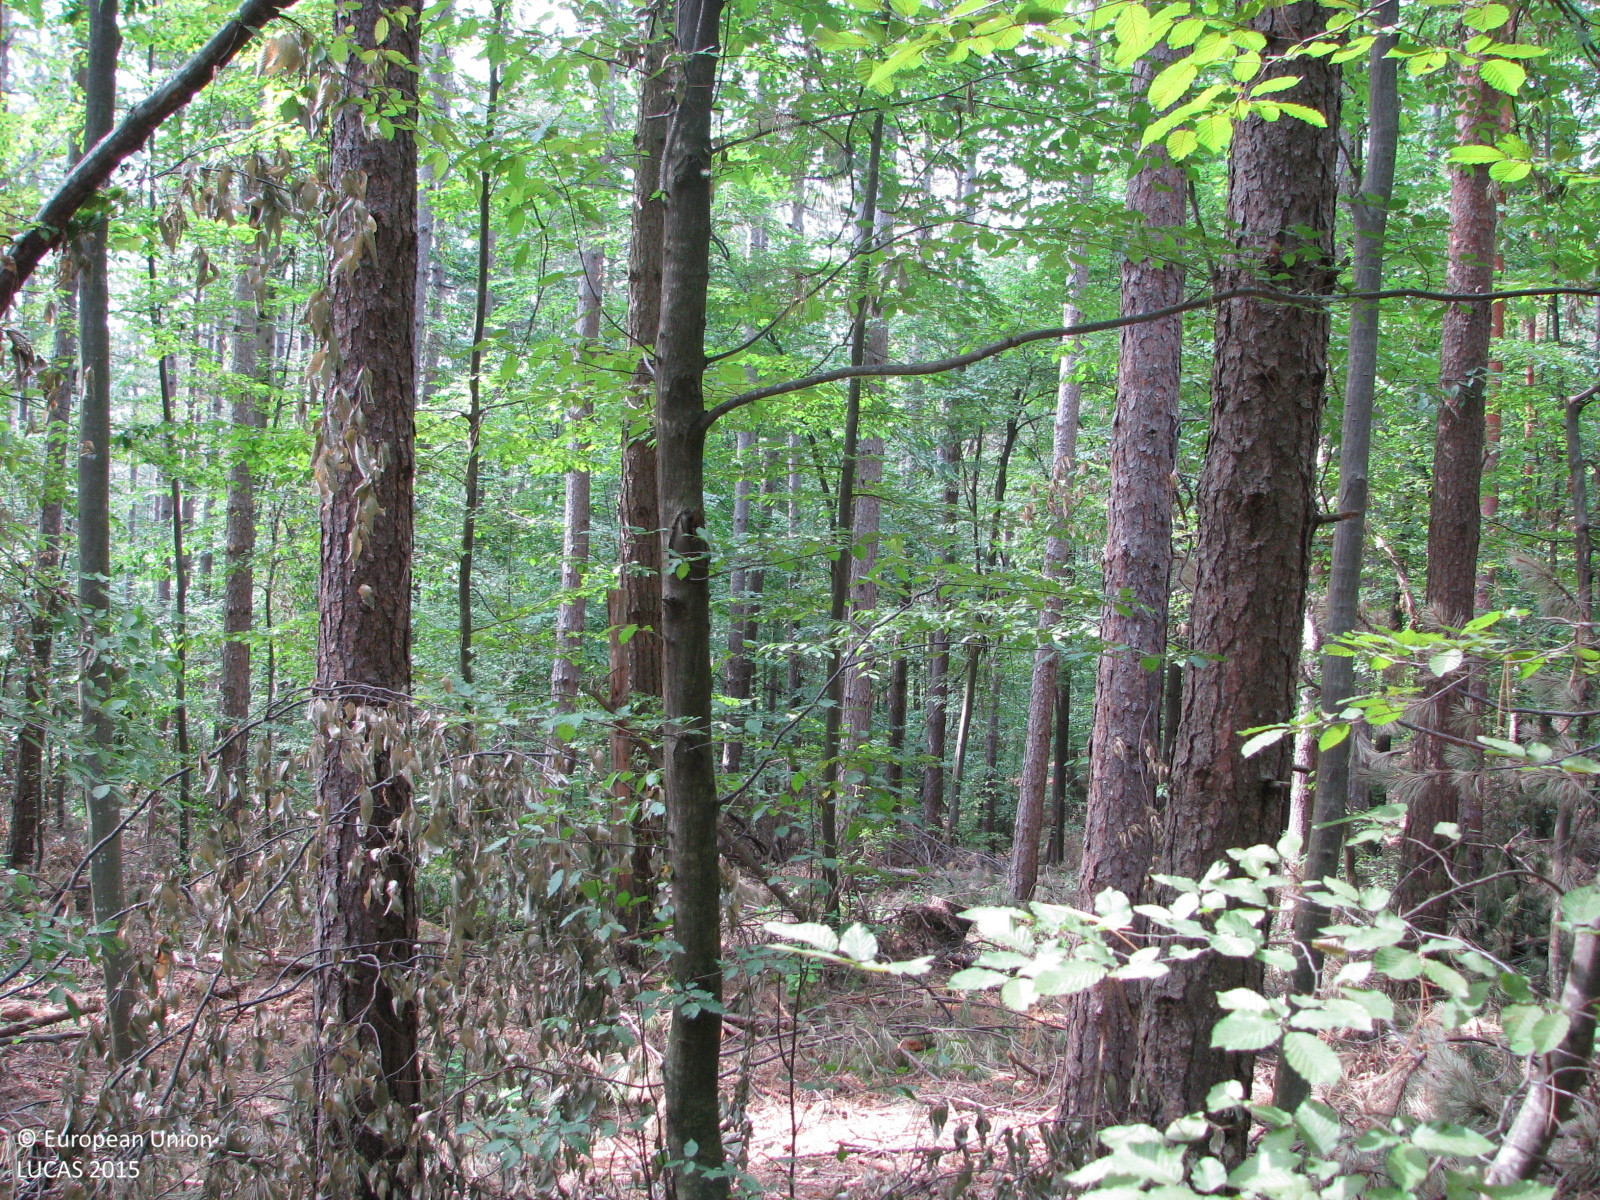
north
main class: Woodland
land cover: Pine dominated mixed woodland
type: coniferous forest of the mediterranean region
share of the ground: > 75 %
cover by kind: coniferous forest trees 45 %, broadleaved forest trees 30 %, consolidated bare surface 15 %, shrubs 5 %, herbaceous plants 5 %
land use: Forestry
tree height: > 5 m
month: August
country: BG
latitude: 42.8538
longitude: 26.1569
